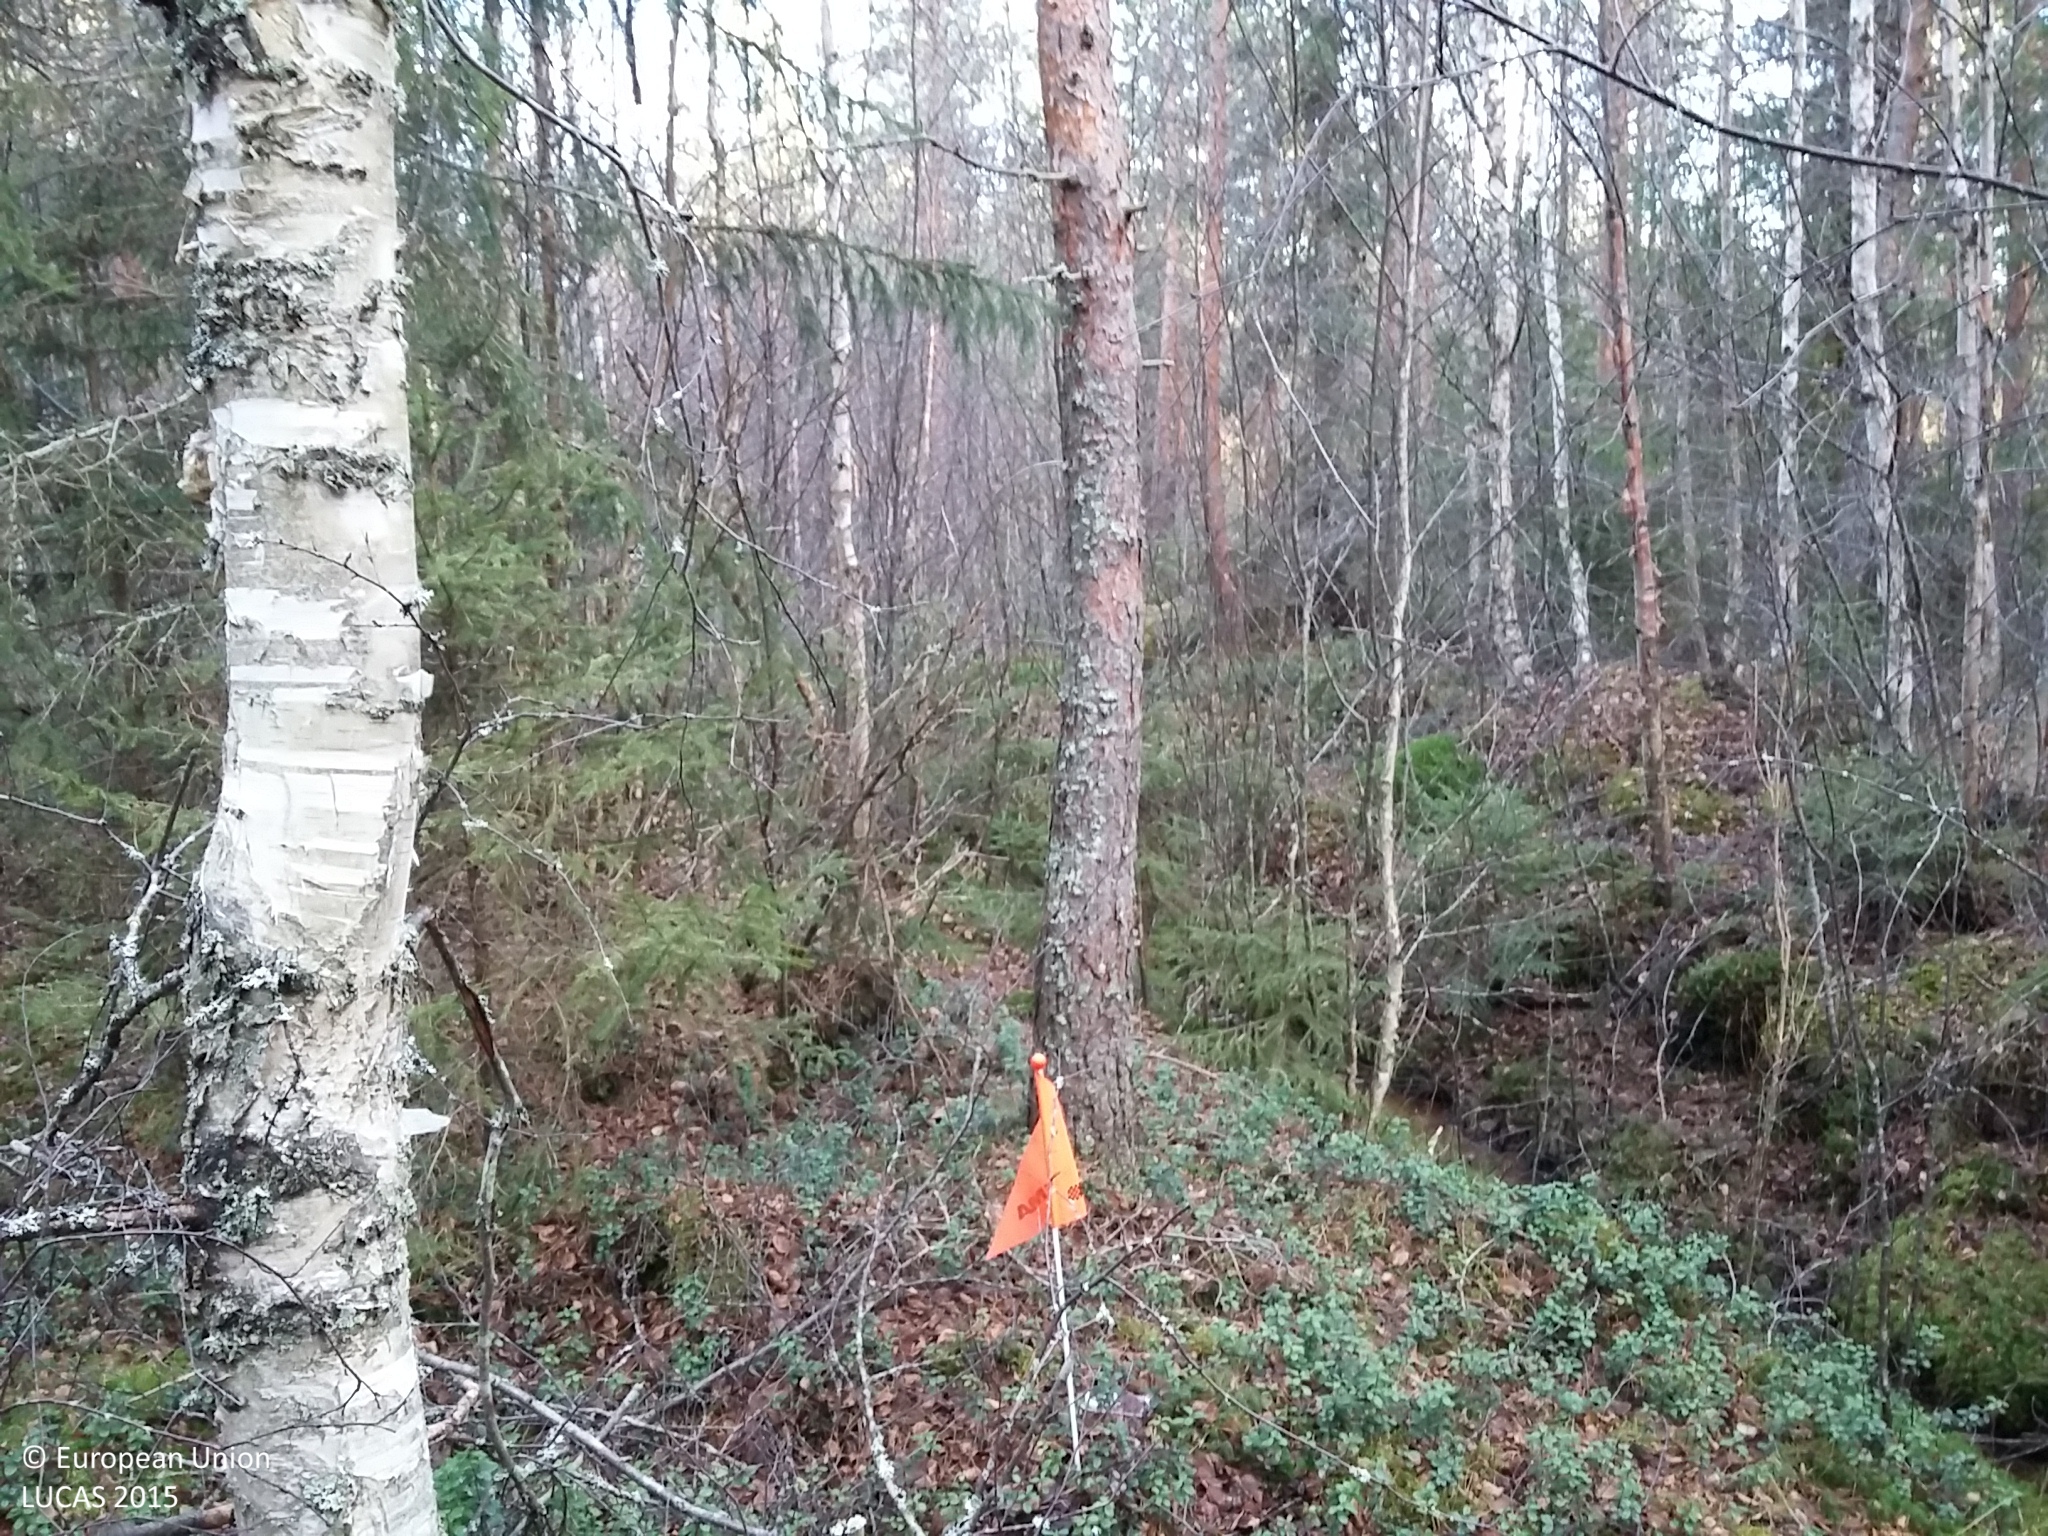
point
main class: Woodland
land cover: Other mixed woodland
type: boreal forest
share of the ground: > 75 %
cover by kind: coniferous forest trees 55 %, broadleaved forest trees 25 %, shrubs 10 %, lichens and mosses 10 %
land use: Forestry
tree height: > 5 m
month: October
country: FI
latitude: 64.5848
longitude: 25.5649
